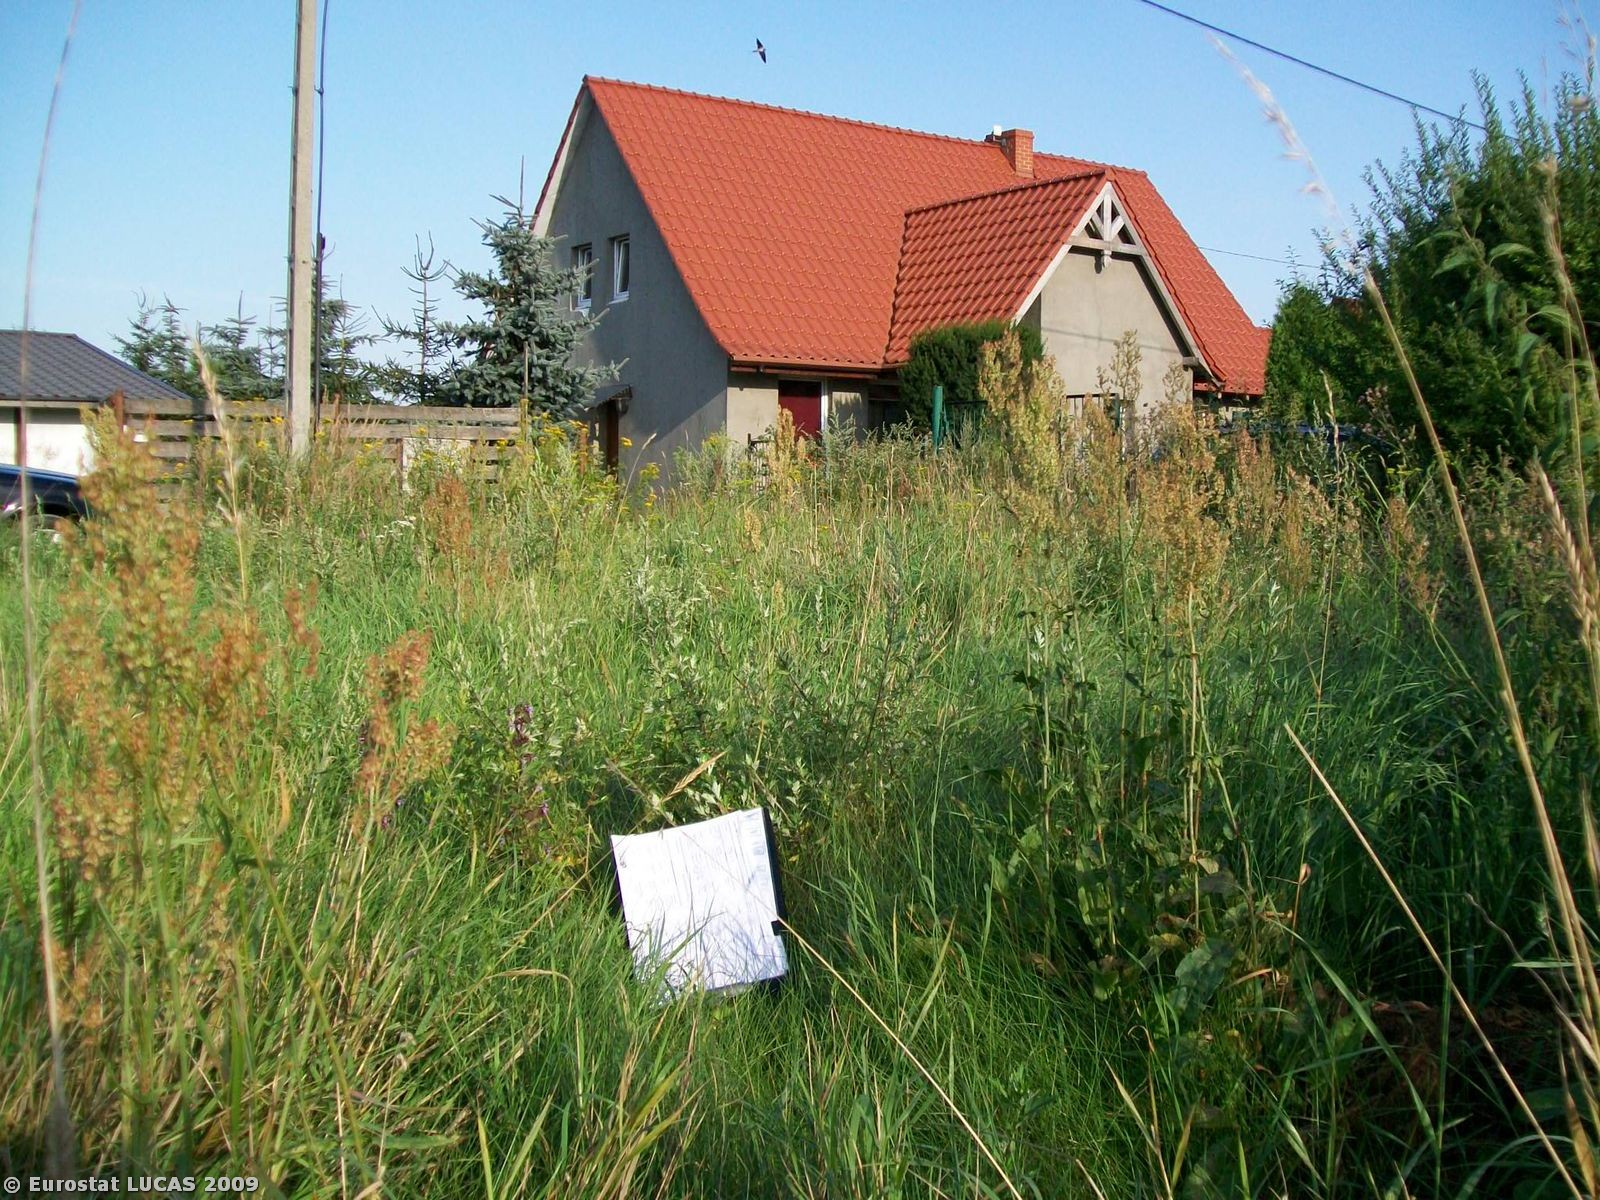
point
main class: Grassland
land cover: Spontaneously vegetated surfaces
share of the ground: > 75 %
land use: Unused
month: August
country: PL
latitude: 51.1362
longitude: 16.7977
